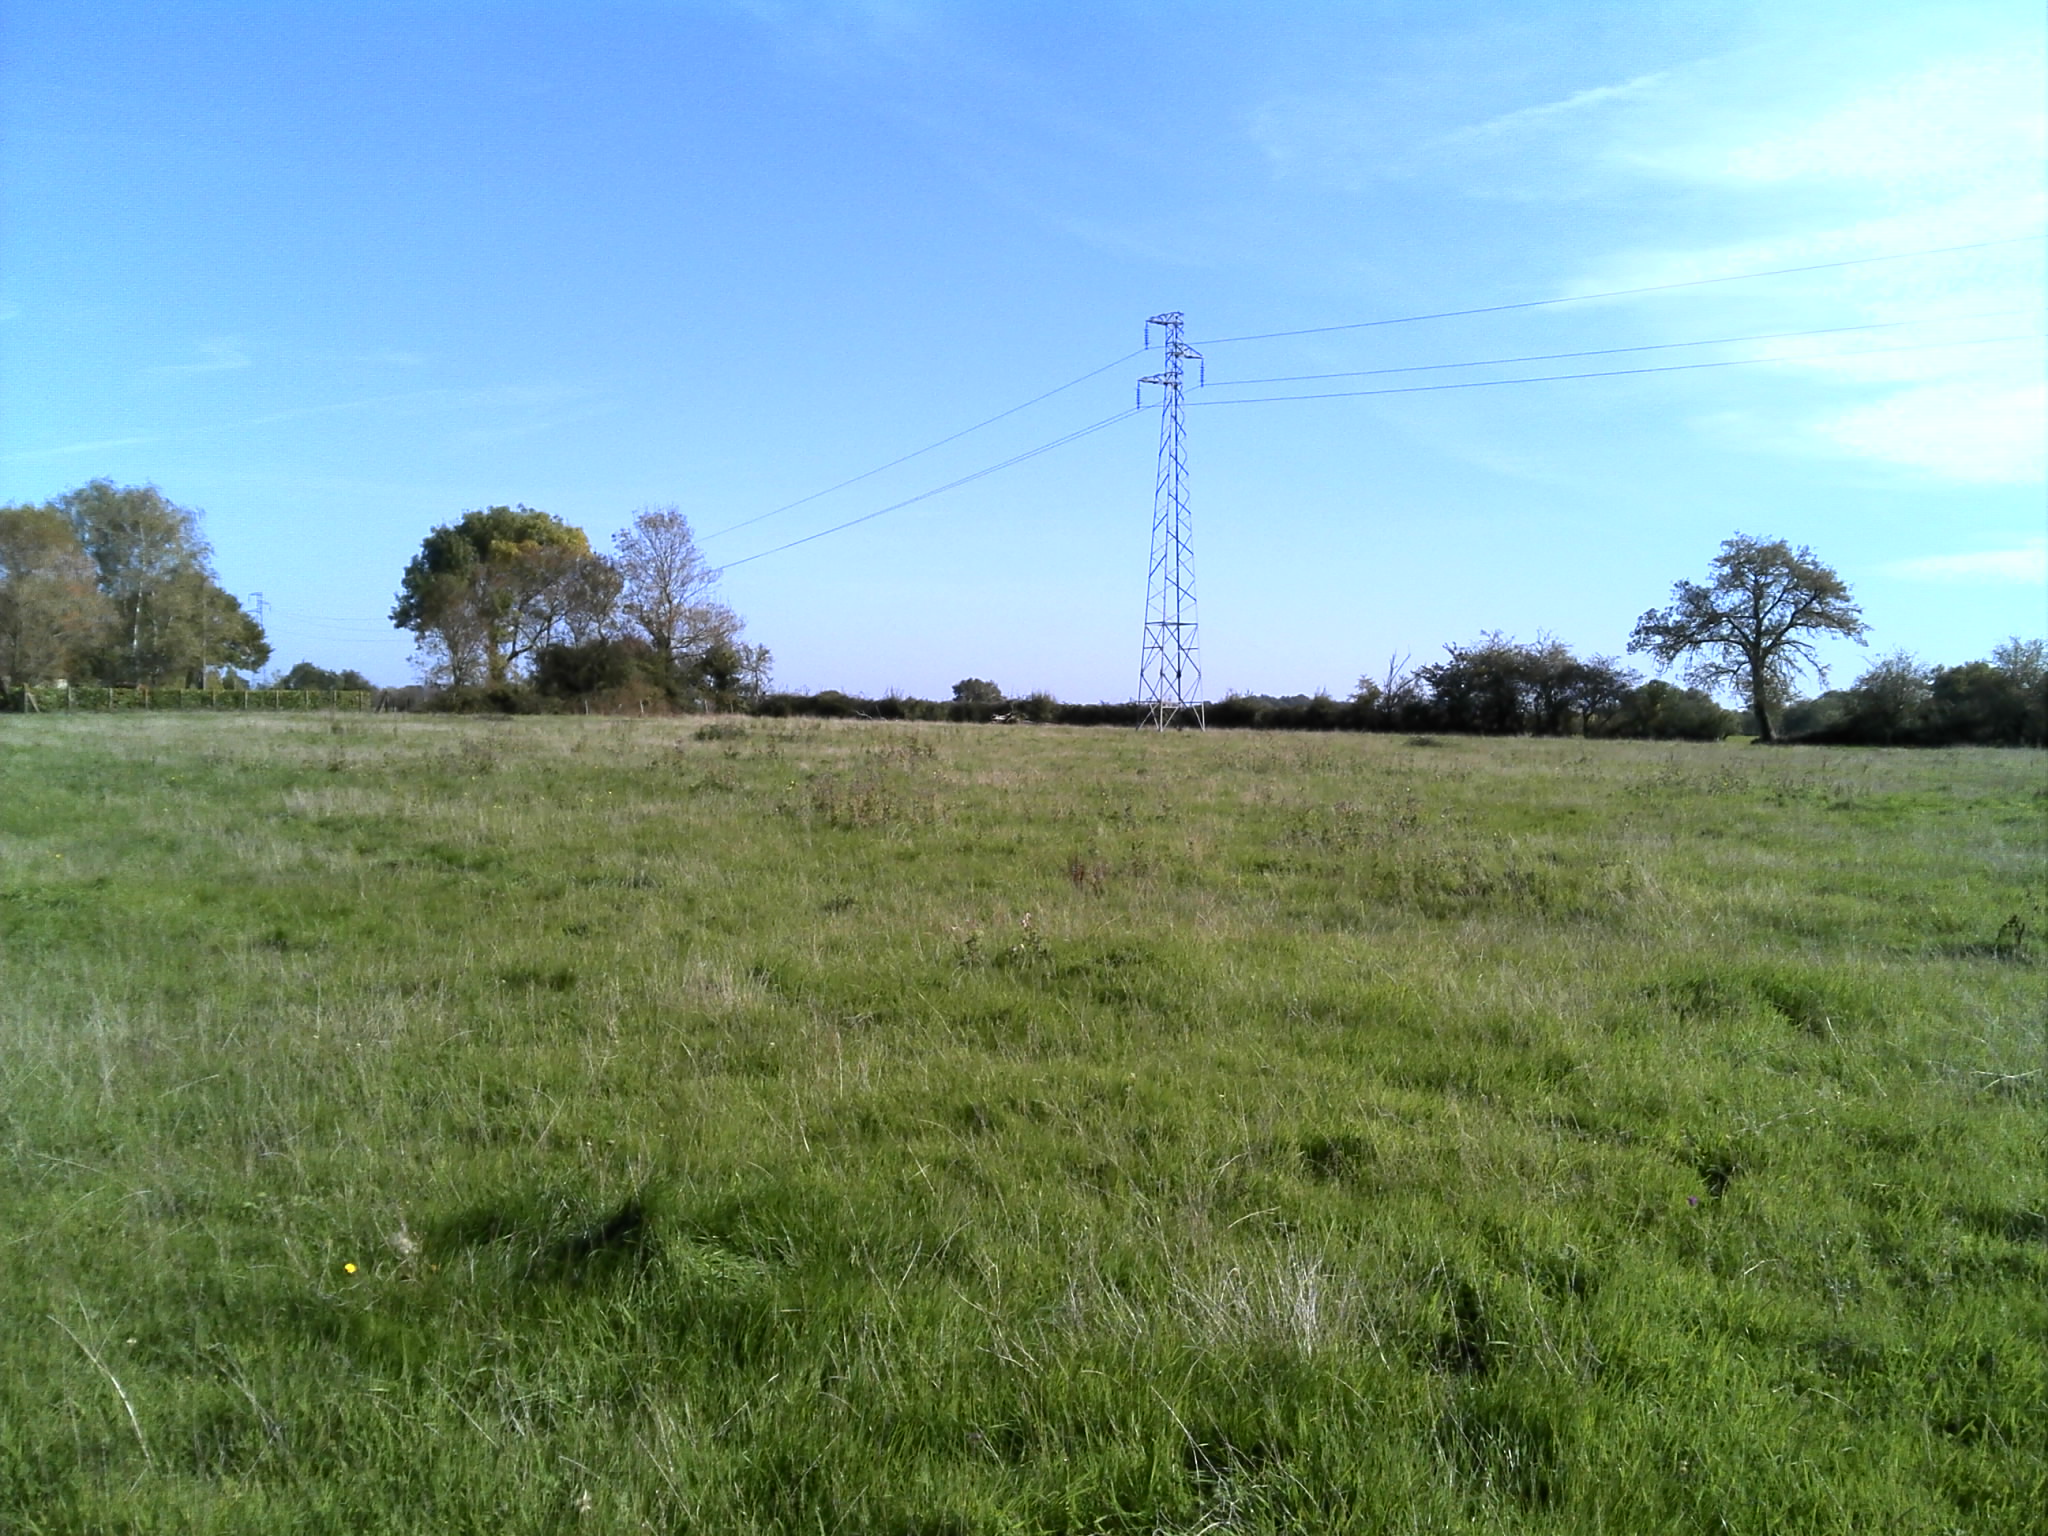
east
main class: Grassland
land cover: Grassland without tree/shrub cover
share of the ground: > 75 %
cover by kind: herbaceous plants 100 %
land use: Agriculture (excluding fallow land and kitchen gardens)
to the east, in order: Grassland without tree/shrub cover; Electric lines; Grassland without tree/shrub cover; Fences; Managed hedges; Fences; Grassland without tree/shrub cover
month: October
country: FR
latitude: 47.3165
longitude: -1.2707
